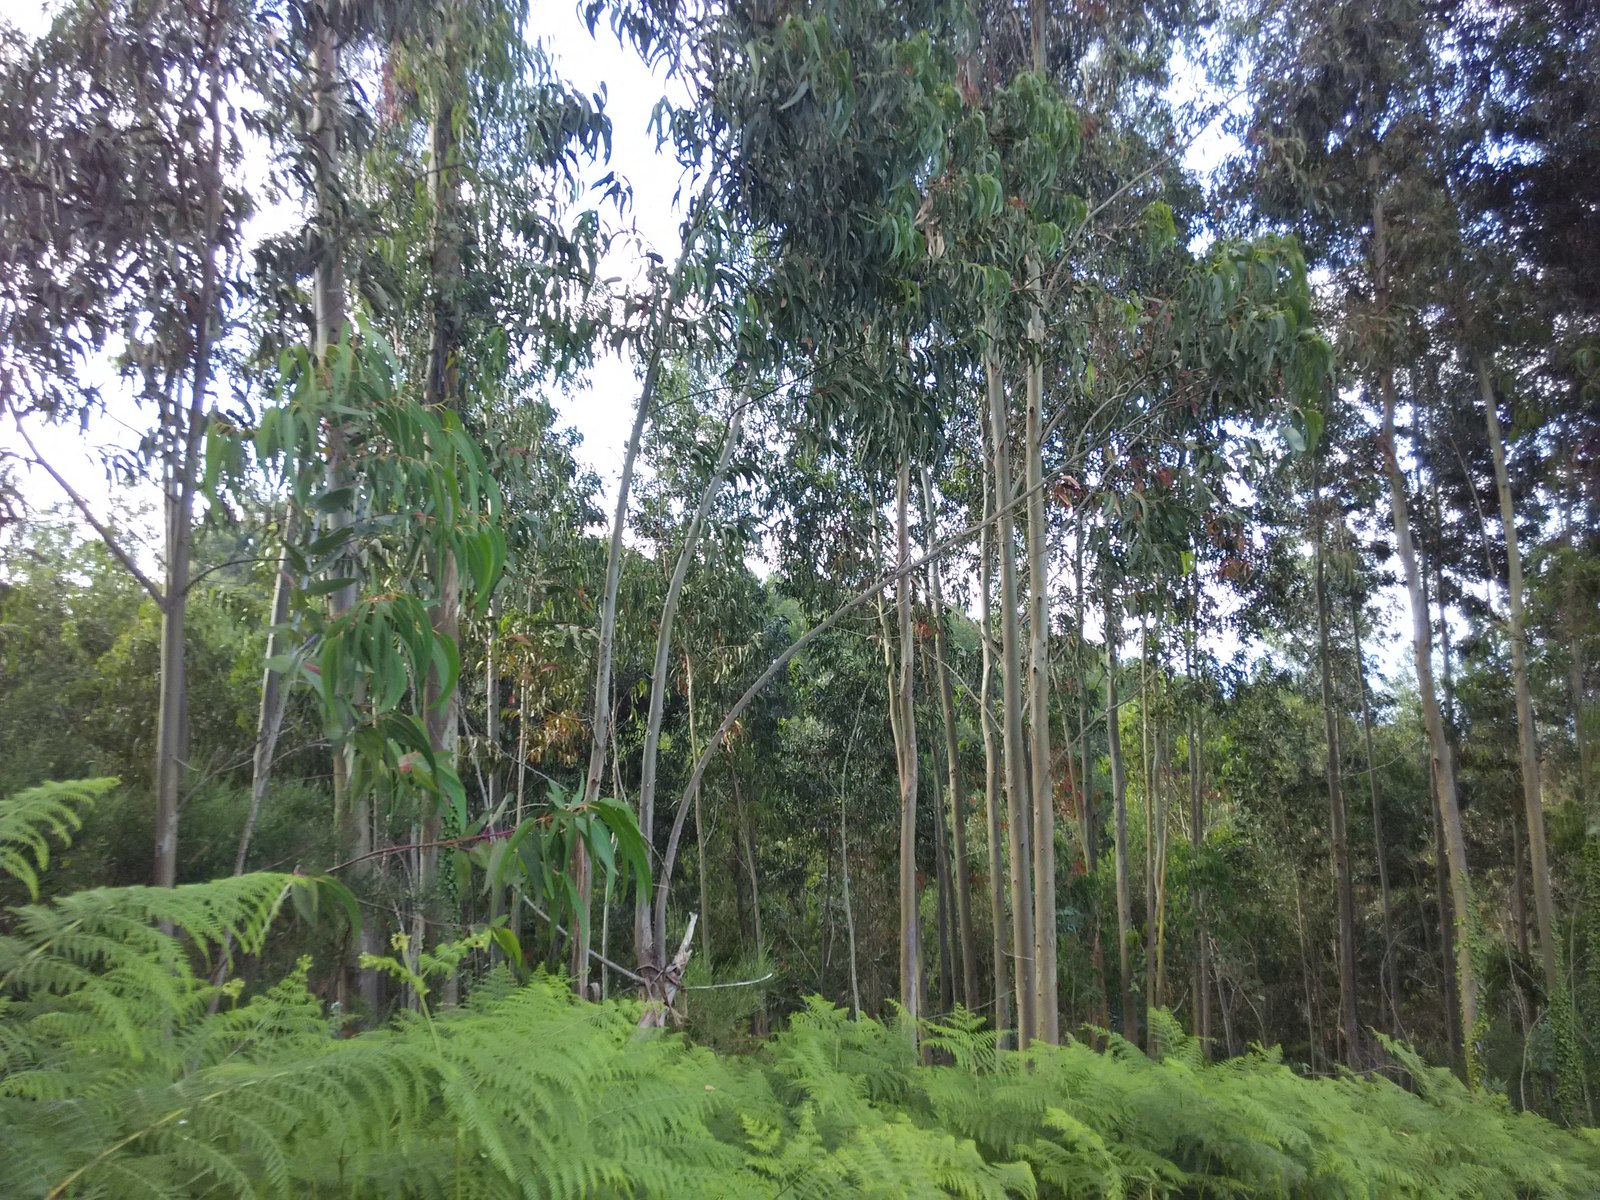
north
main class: Woodland
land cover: Broadleaved woodland
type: exotic forest
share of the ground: > 75 %
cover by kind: broadleaved forest trees 90 %, shrubs 10 %
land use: Forestry
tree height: > 5 m
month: June
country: ES
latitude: 43.3392
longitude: -2.4745
